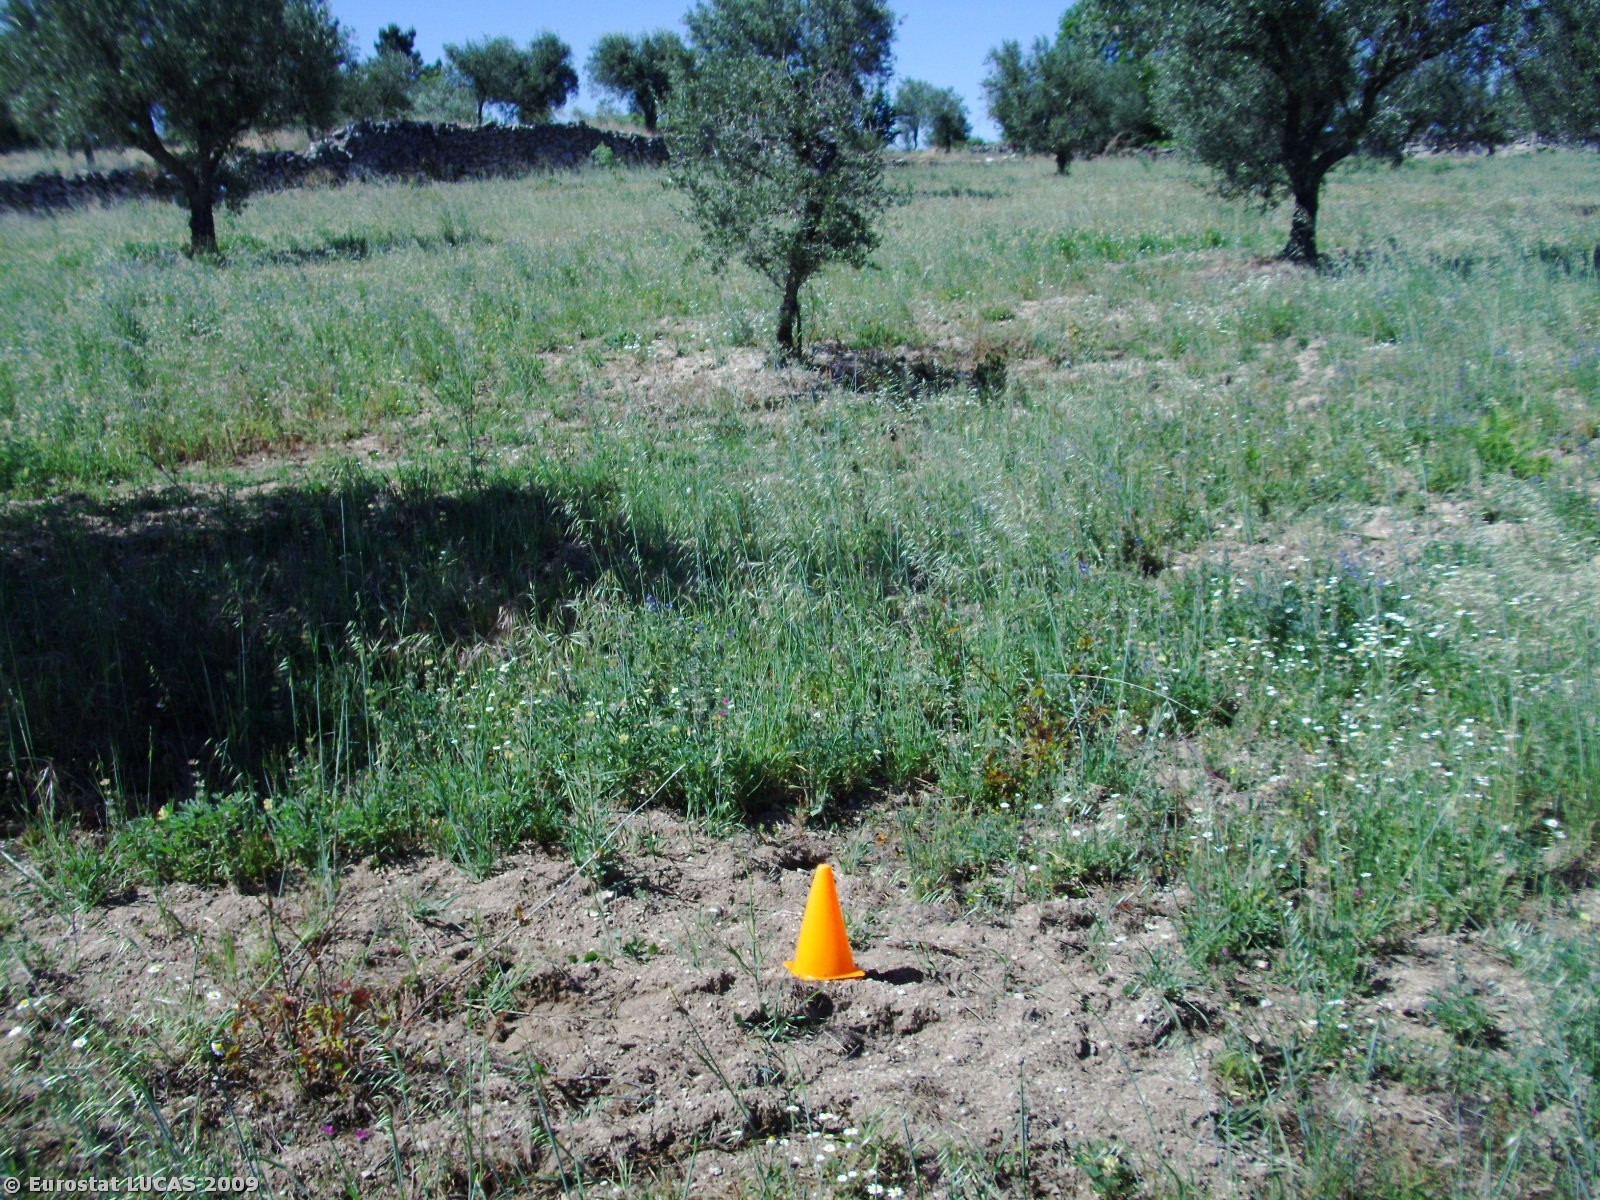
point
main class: Cropland
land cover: Olive groves
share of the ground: 50 - 75 %
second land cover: Spontaneously vegetated surfaces
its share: 25 - 50 %
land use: Agriculture (excluding fallow land and kitchen gardens)
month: May
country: PT
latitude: 40.9249
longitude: -7.5397
